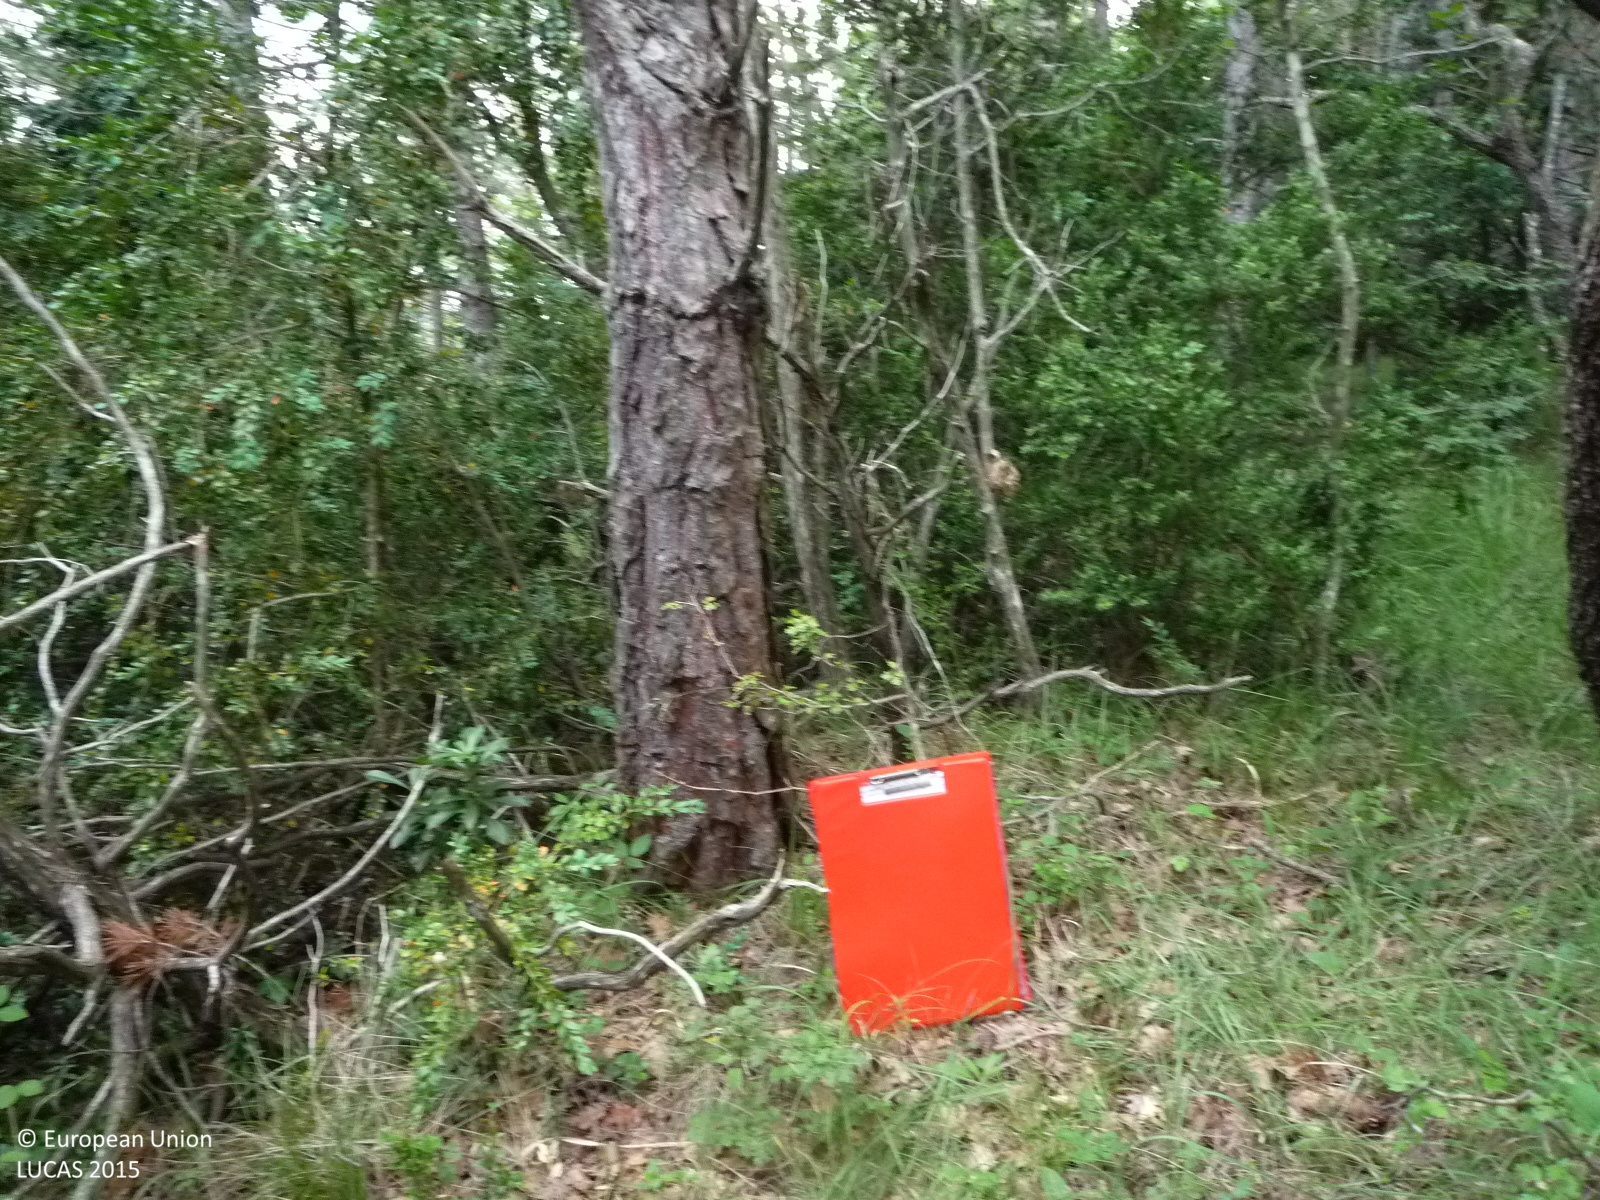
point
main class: Woodland
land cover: Pine dominated mixed woodland
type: alpine coniferous forest
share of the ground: > 75 %
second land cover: Shrubland without tree cover
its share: < 10 %
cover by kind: coniferous forest trees 60 %, broadleaved forest trees 30 %, shrubs 10 %
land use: Forestry
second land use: Agriculture (excluding fallow land and kitchen gardens)
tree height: > 5 m
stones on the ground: < 10 %
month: June
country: ES
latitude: 42.2626
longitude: 1.9749
